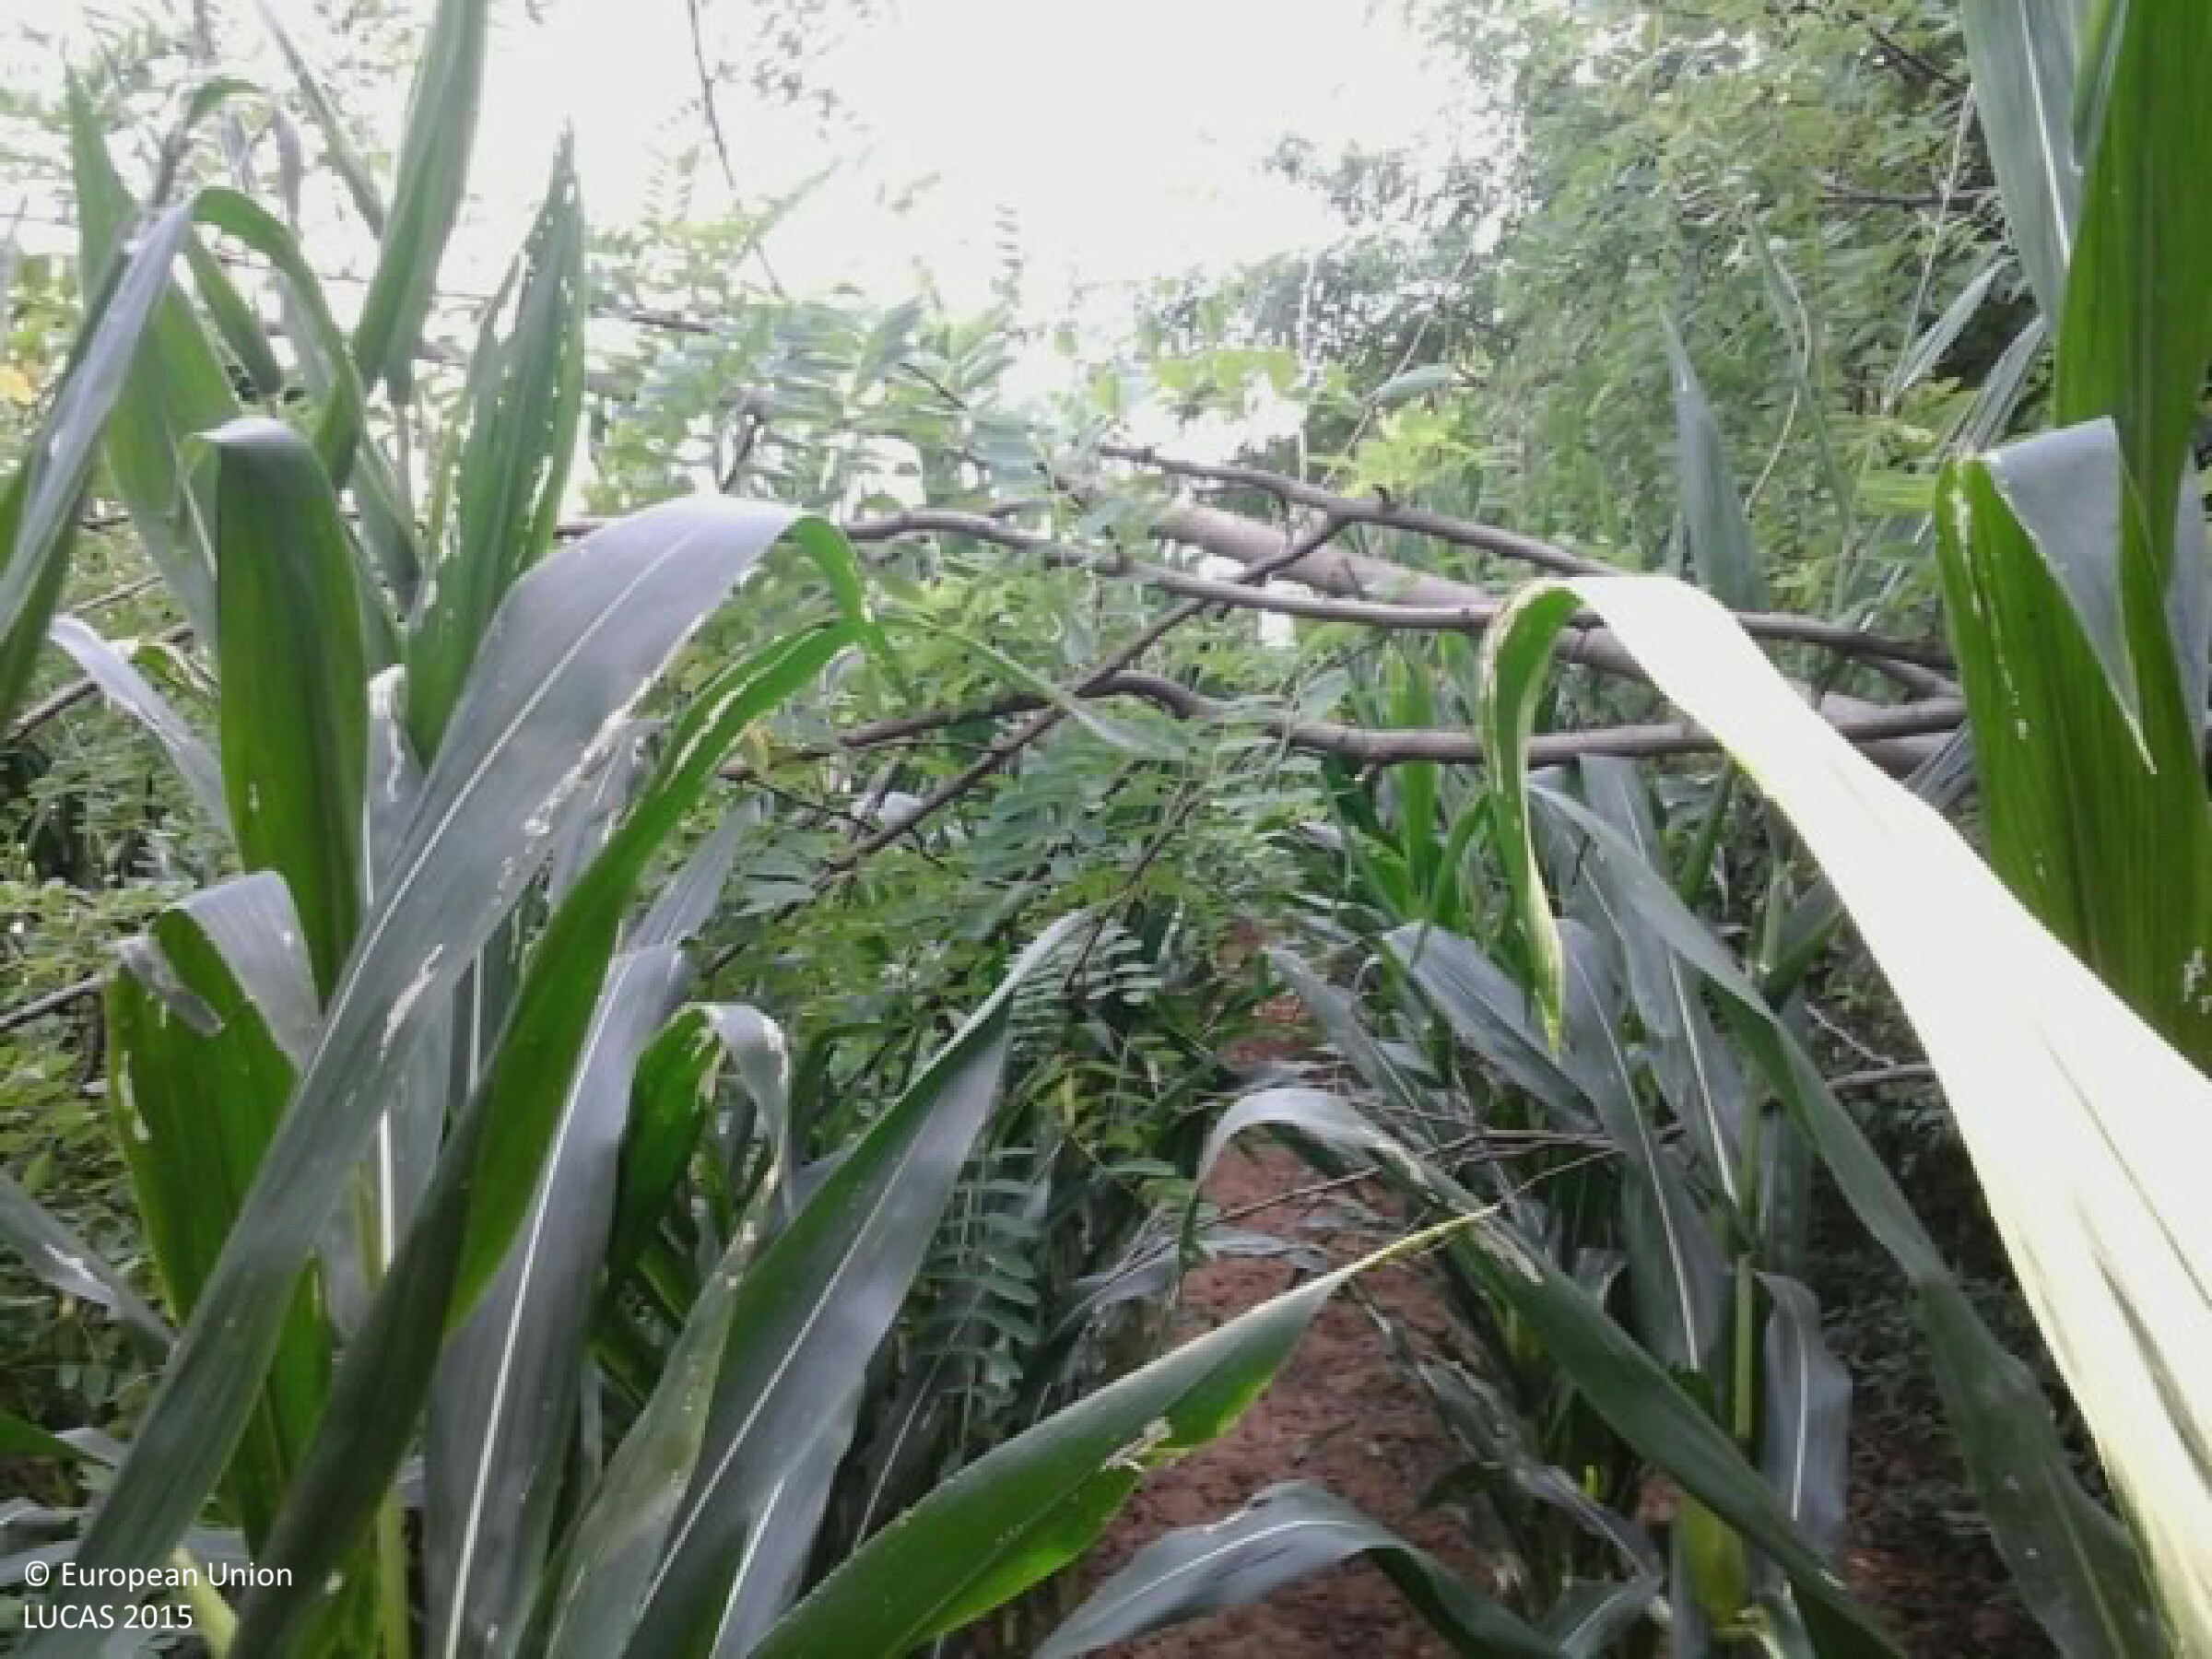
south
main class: Cropland
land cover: Maize
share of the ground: > 75 %
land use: Agriculture (excluding fallow land and kitchen gardens)
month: August
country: HU
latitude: 46.4682
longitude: 17.9901
